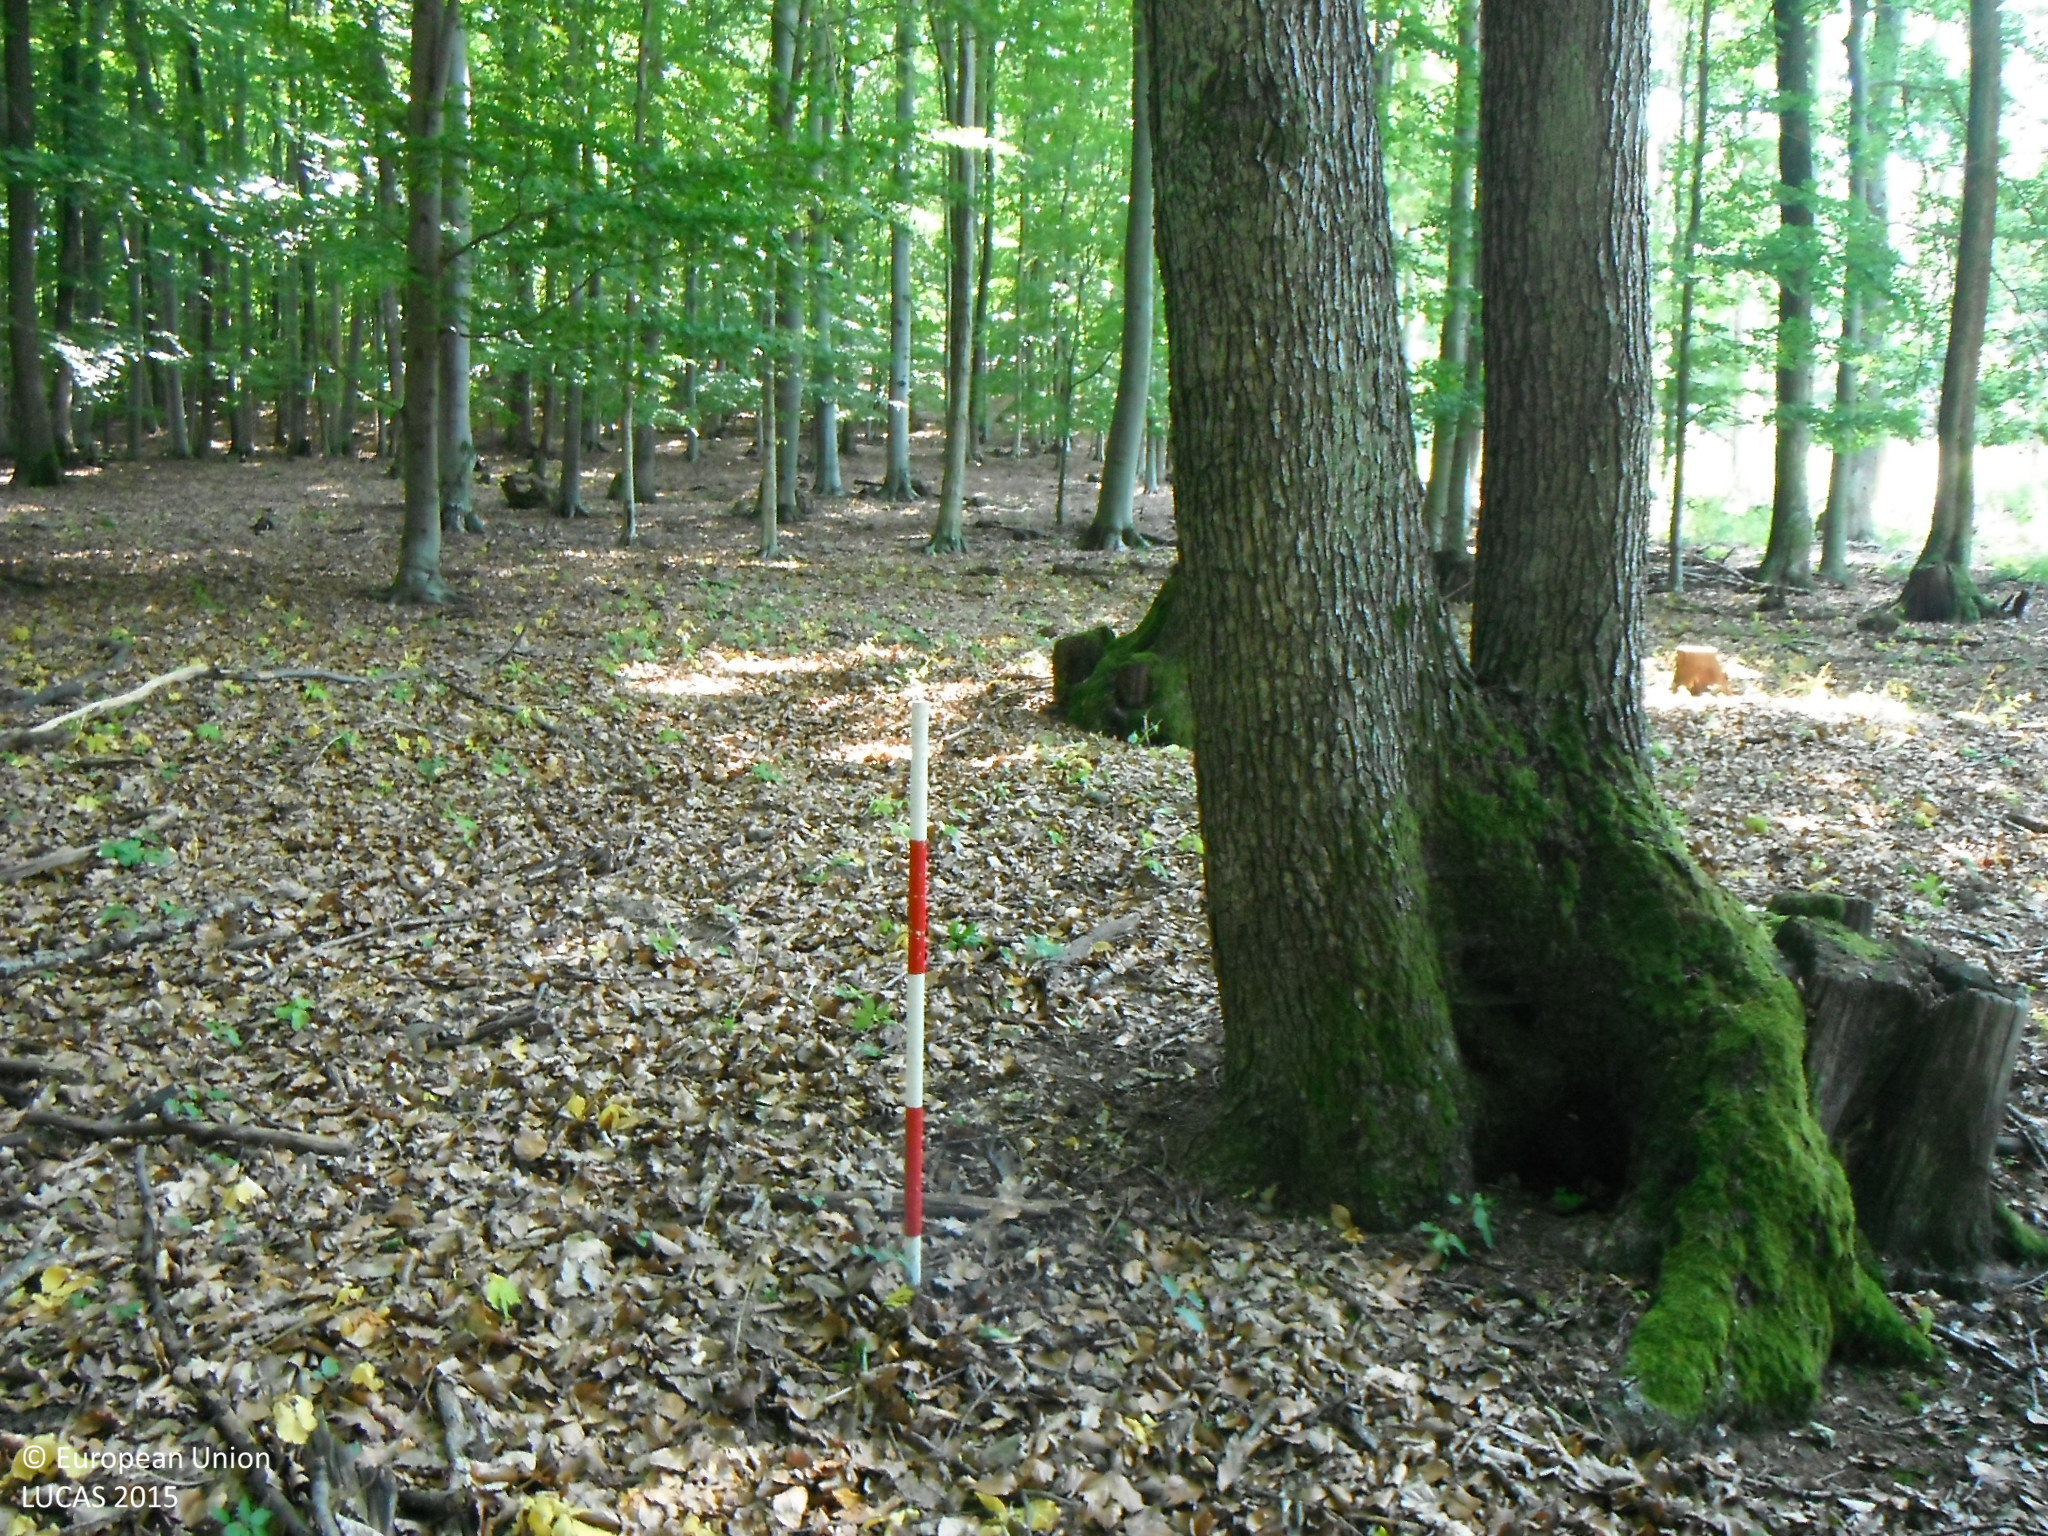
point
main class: Woodland
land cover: Broadleaved woodland
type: mesophytic deciduous forest
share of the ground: > 75 %
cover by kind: broadleaved forest trees 100 %
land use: Forestry
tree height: > 5 m
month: July
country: SK
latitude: 48.2328
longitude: 19.2441
